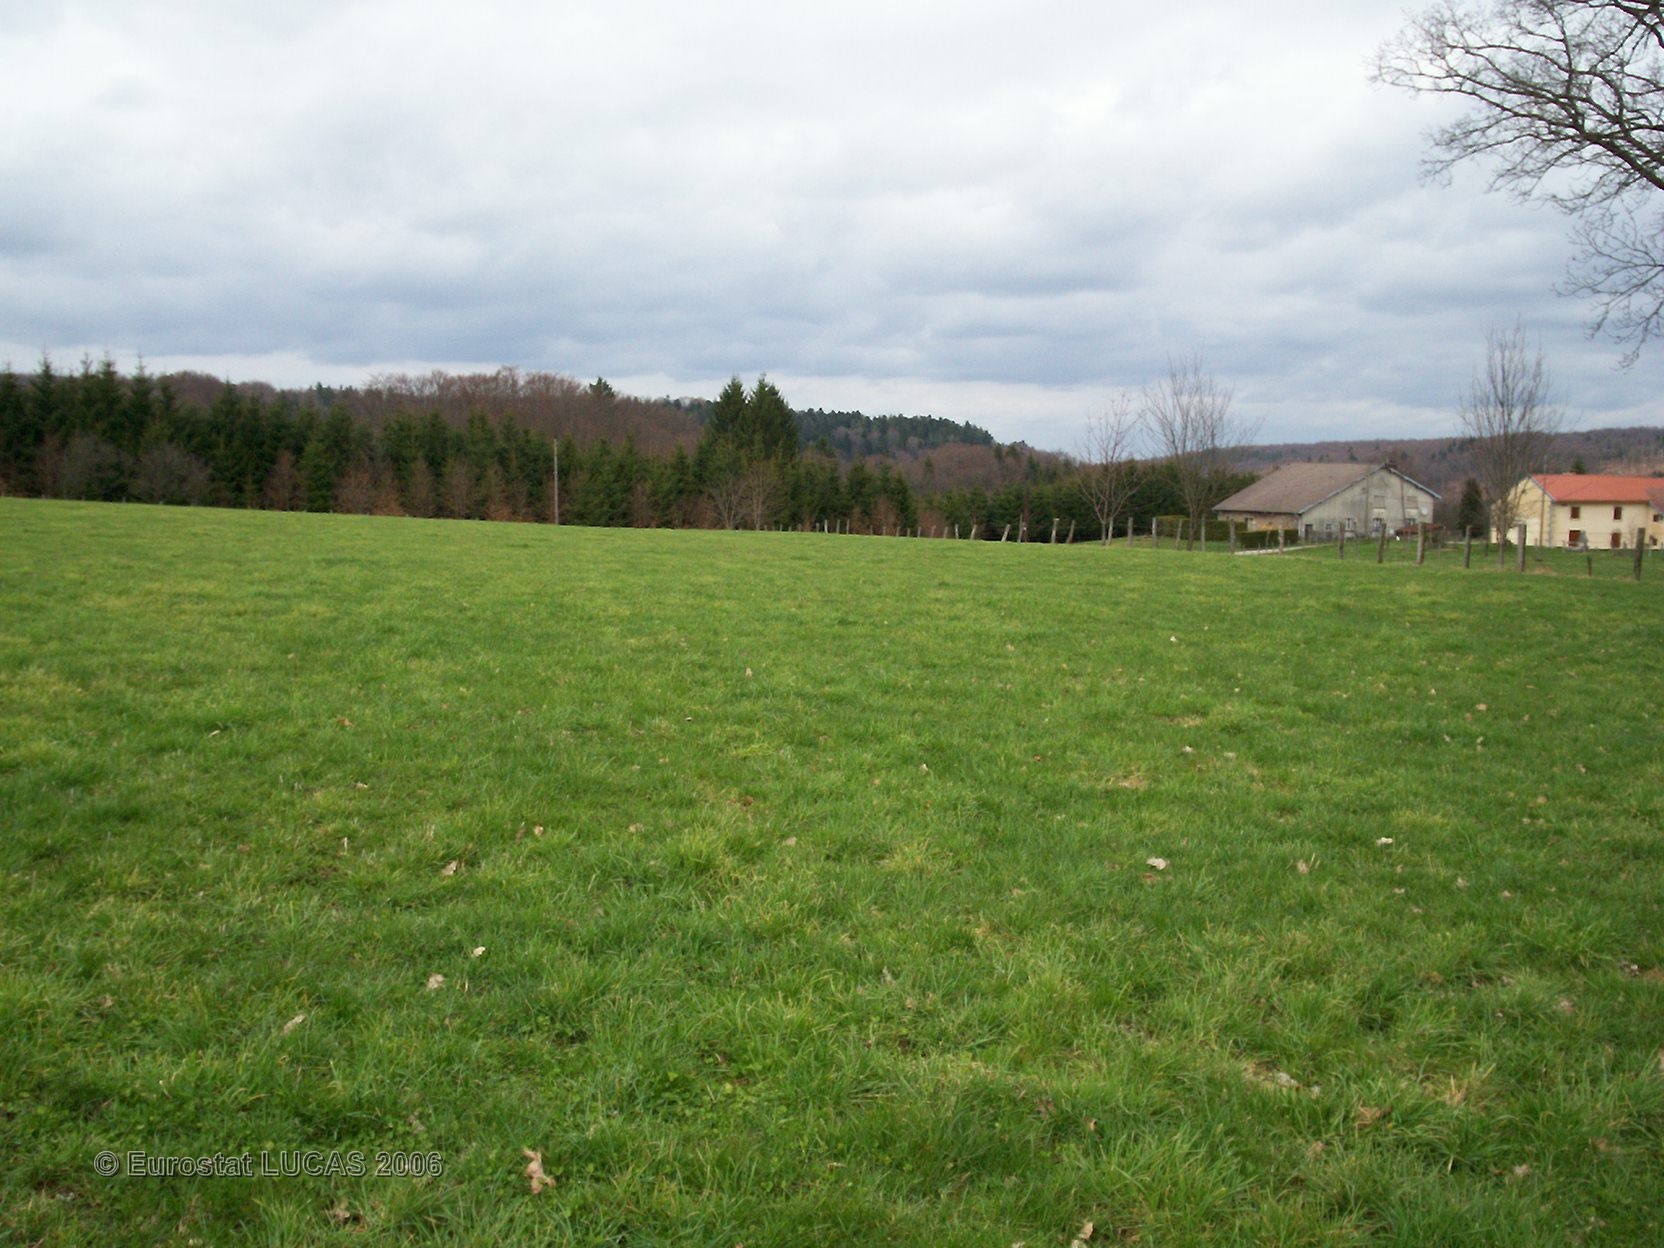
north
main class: Grassland
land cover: Grassland without tree/shrub cover
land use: Agriculture (excluding fallow land and kitchen gardens)
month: April
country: FR
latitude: 48.0240
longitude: 6.5013
